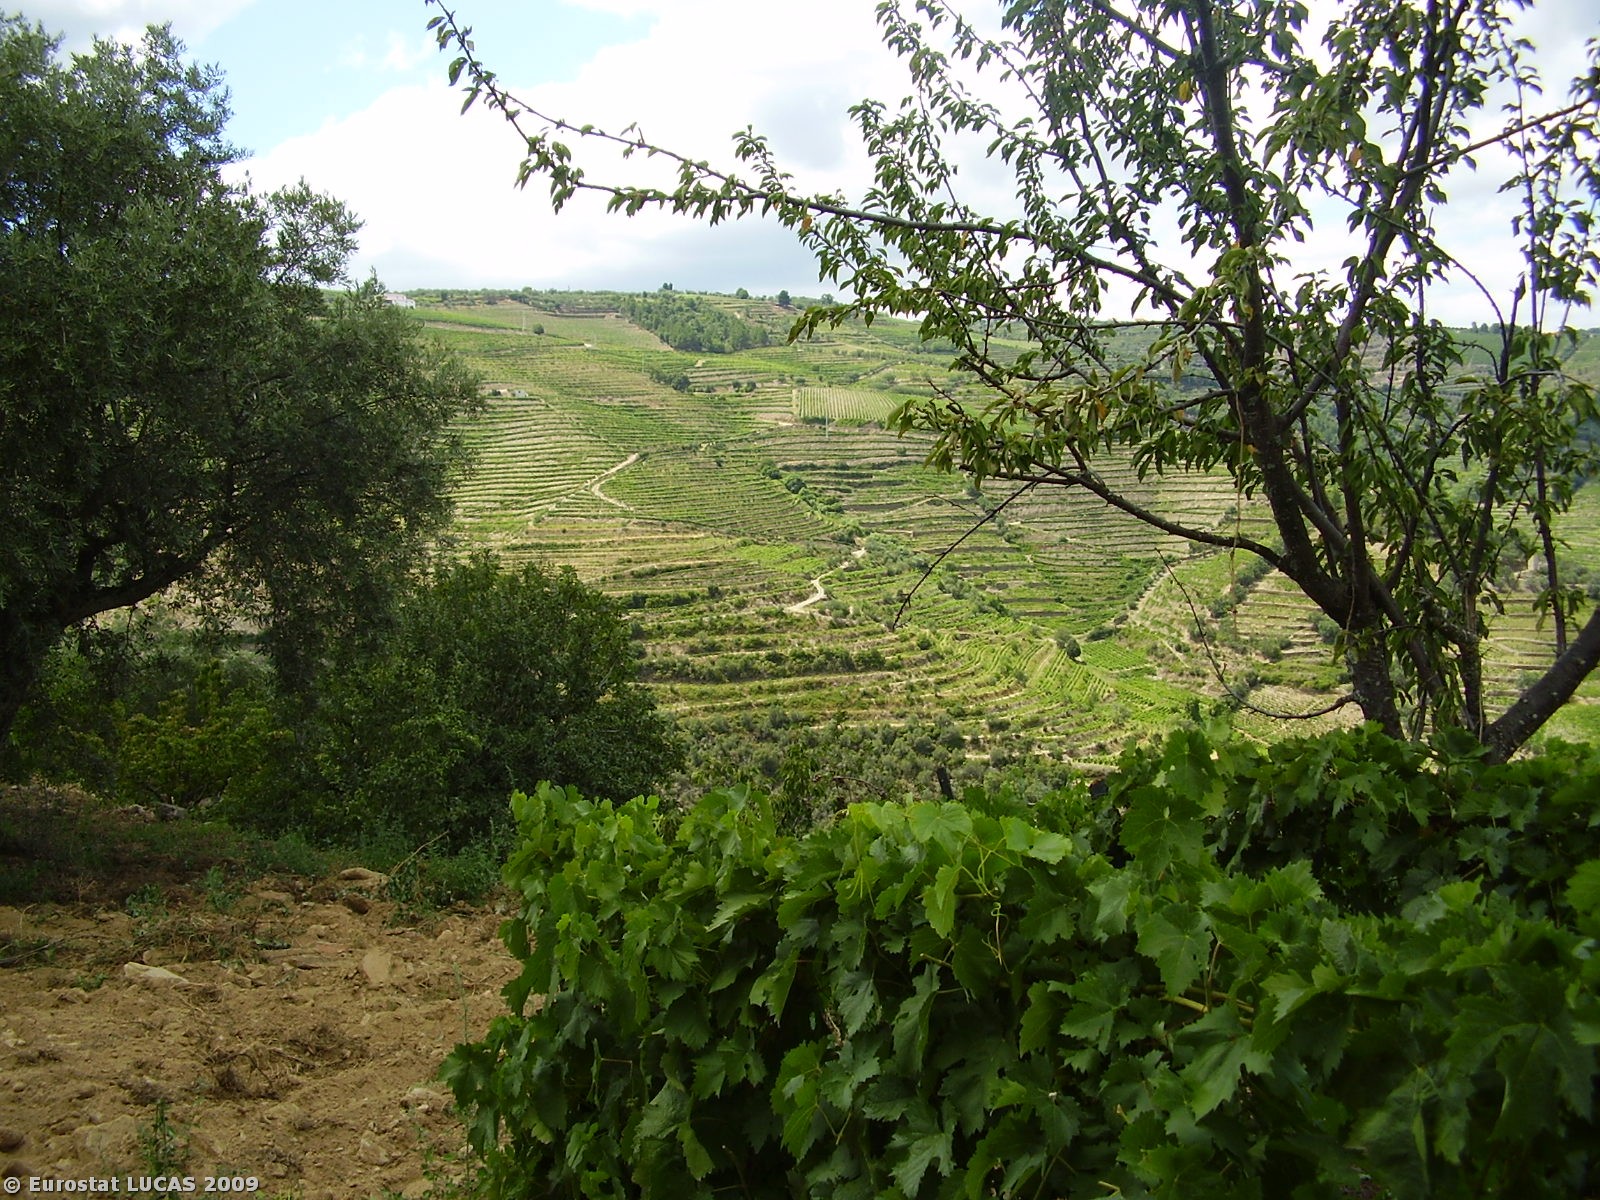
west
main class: Cropland
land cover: Vineyards
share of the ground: < 10 %
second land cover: Bare land
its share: < 10 %
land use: Agriculture (excluding fallow land and kitchen gardens)
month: July
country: PT
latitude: 41.2397
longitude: -7.5325
